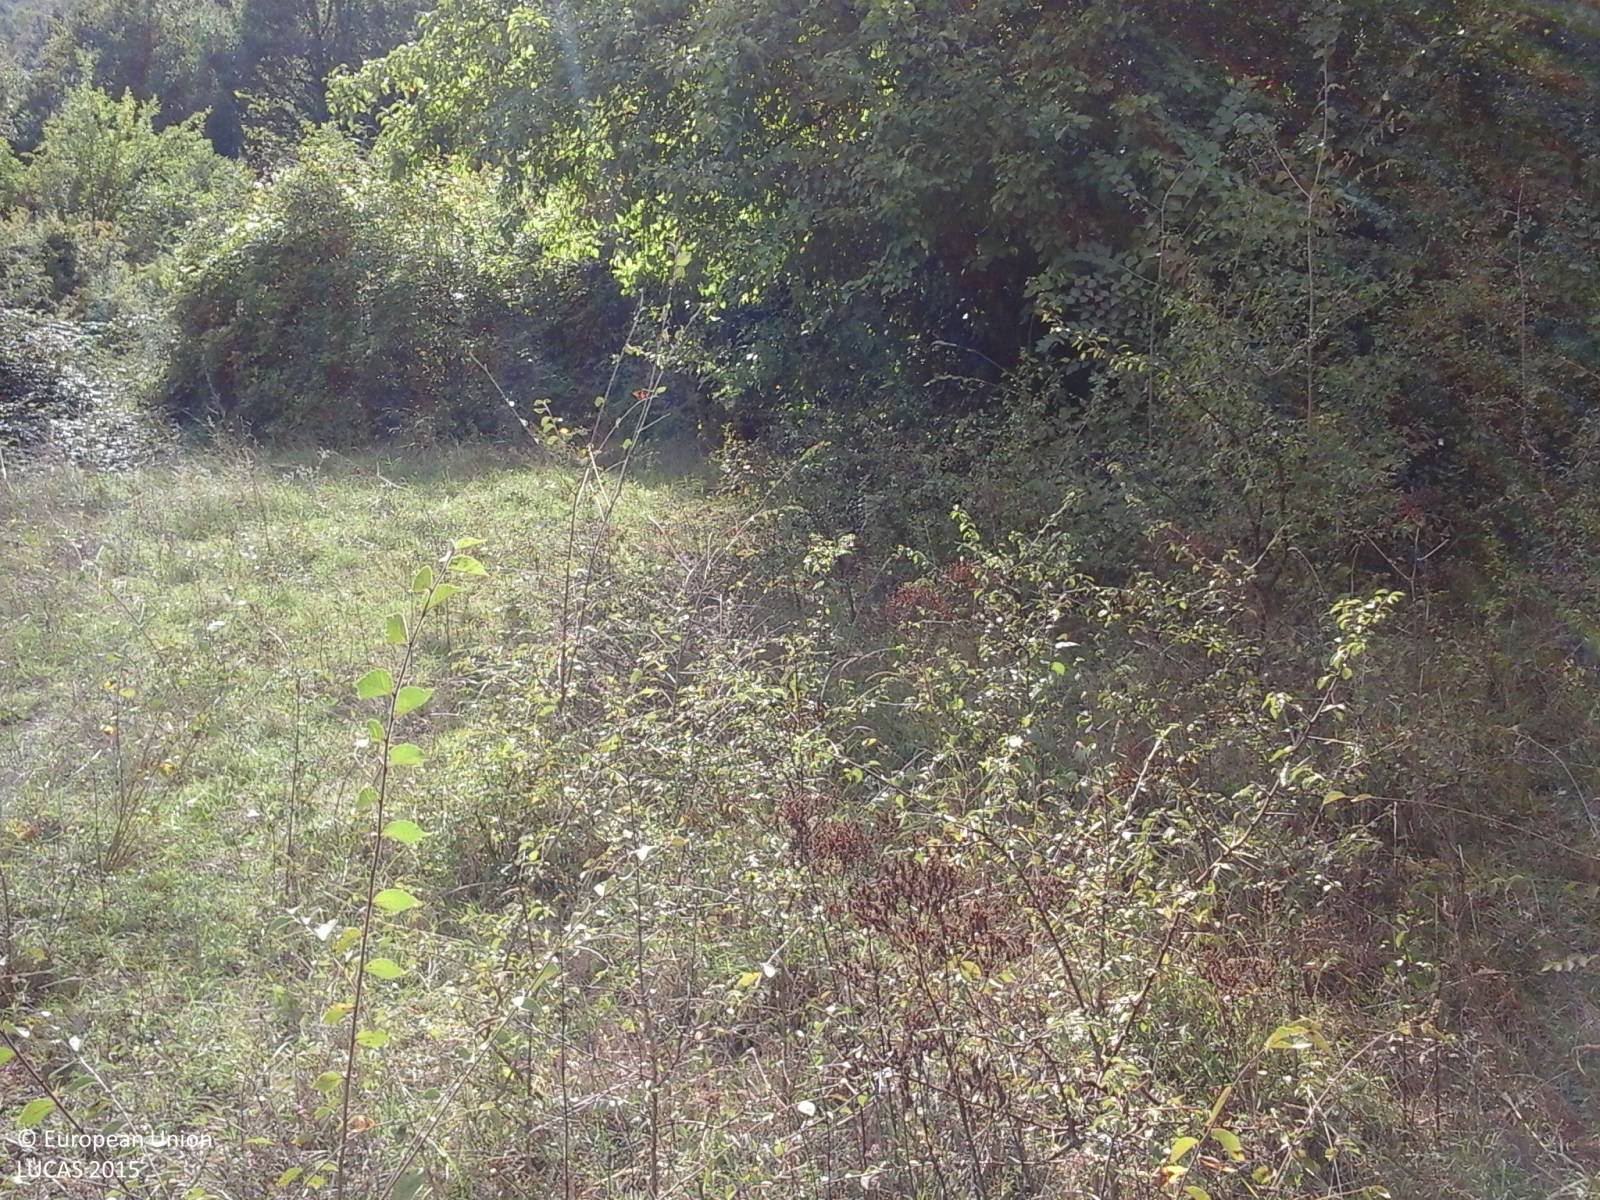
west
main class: Shrubland
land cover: Shrubland with sparse tree cover
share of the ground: > 75 %
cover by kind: shrubs 95 %, broadleaved forest trees 5 %
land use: Abandoned areas
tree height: < 5 m
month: September
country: IT
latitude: 42.3857
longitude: 12.6027
